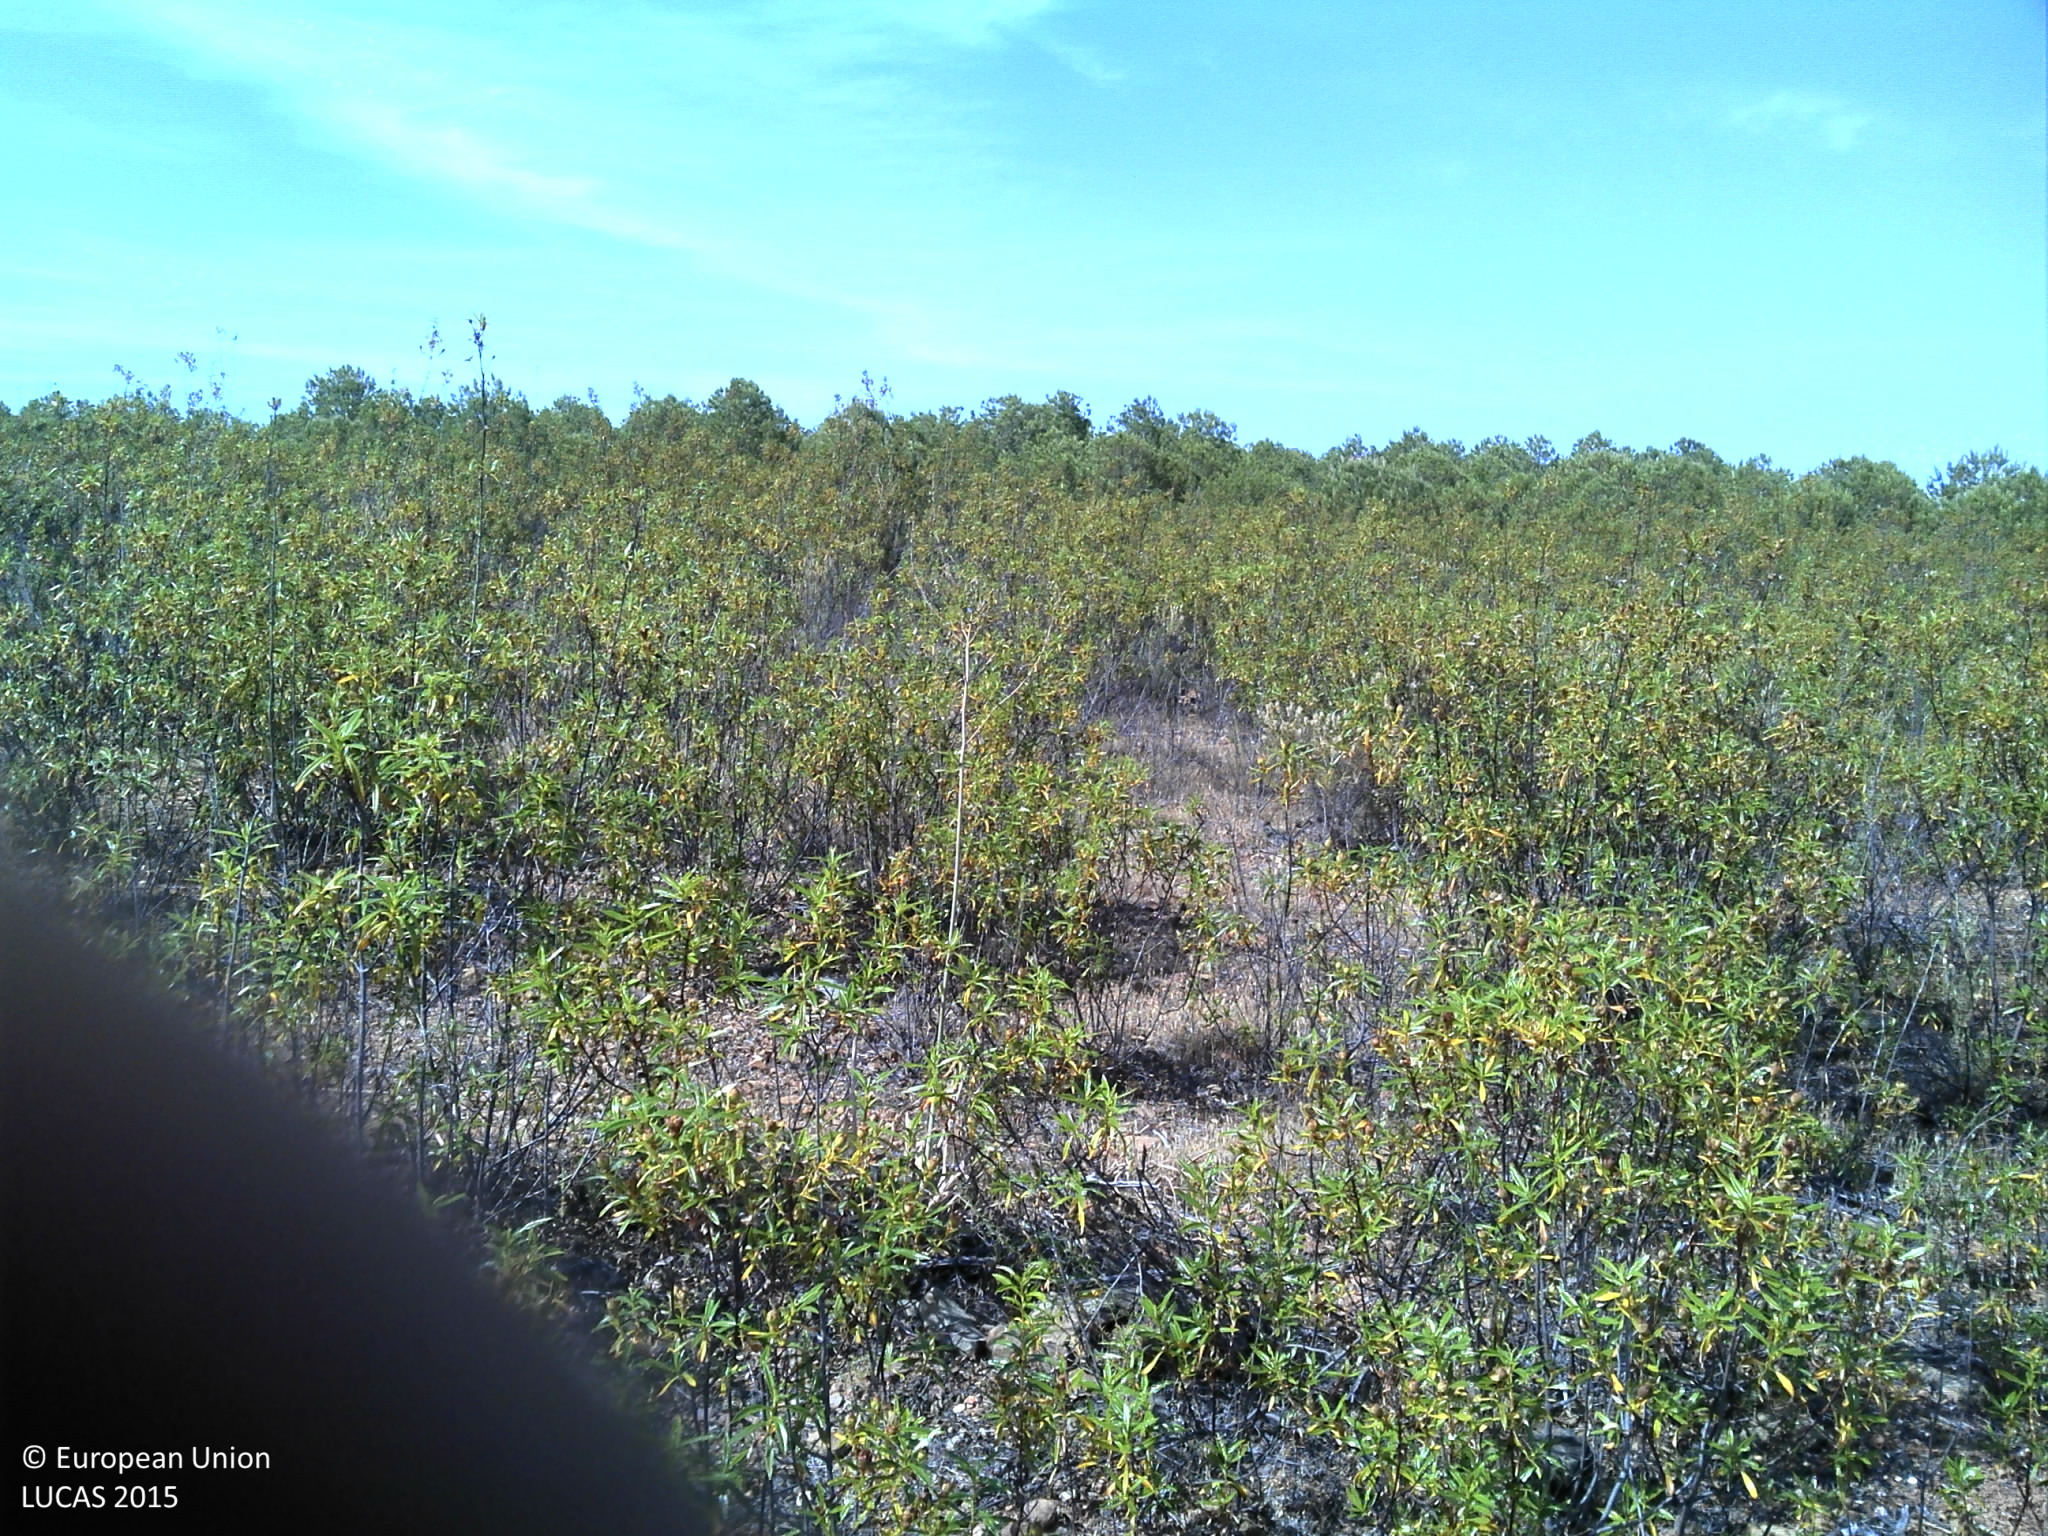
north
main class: Shrubland
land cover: Shrubland with sparse tree cover
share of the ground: > 75 %
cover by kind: shrubs 95 %, broadleaved forest trees 5 %
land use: Abandoned areas
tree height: < 5 m
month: May
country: PT
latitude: 37.3122
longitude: -7.5060
